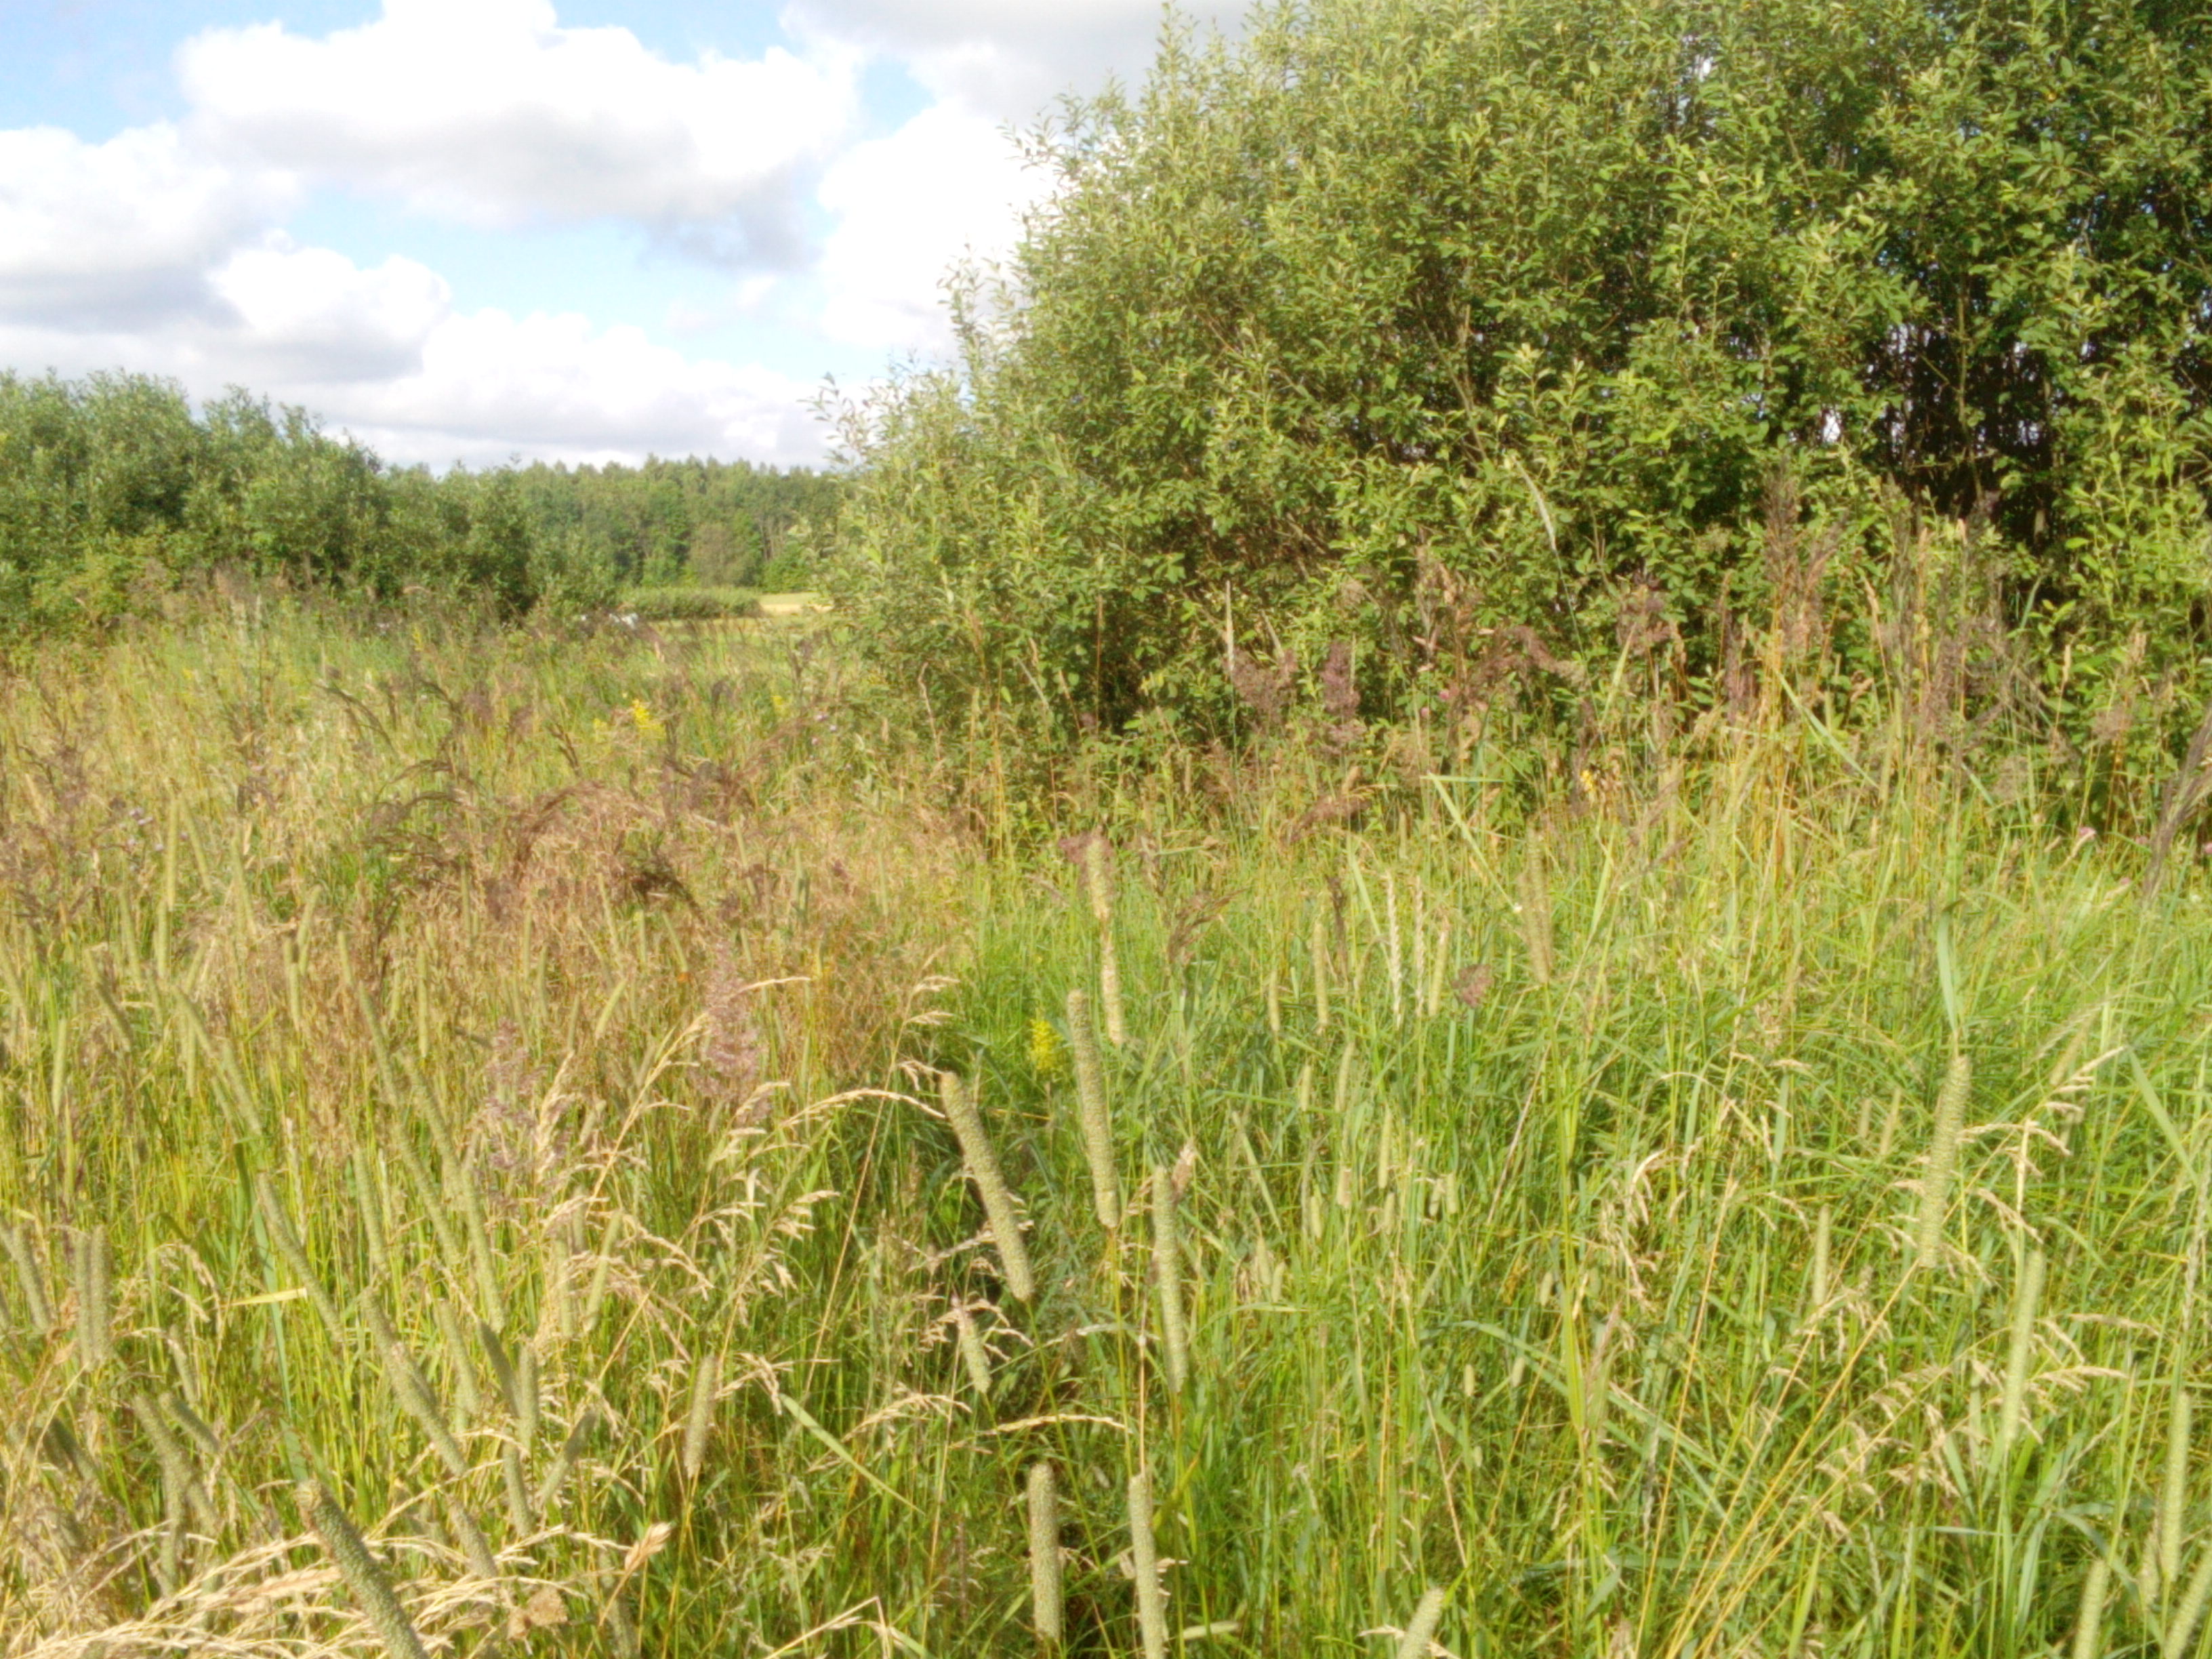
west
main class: Grassland
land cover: Grassland without tree/shrub cover
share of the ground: > 75 %
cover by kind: herbaceous plants 95 %, shrubs 5 %
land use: Agriculture (excluding fallow land and kitchen gardens)
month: July
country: LV
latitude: 56.6848
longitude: 21.3196
